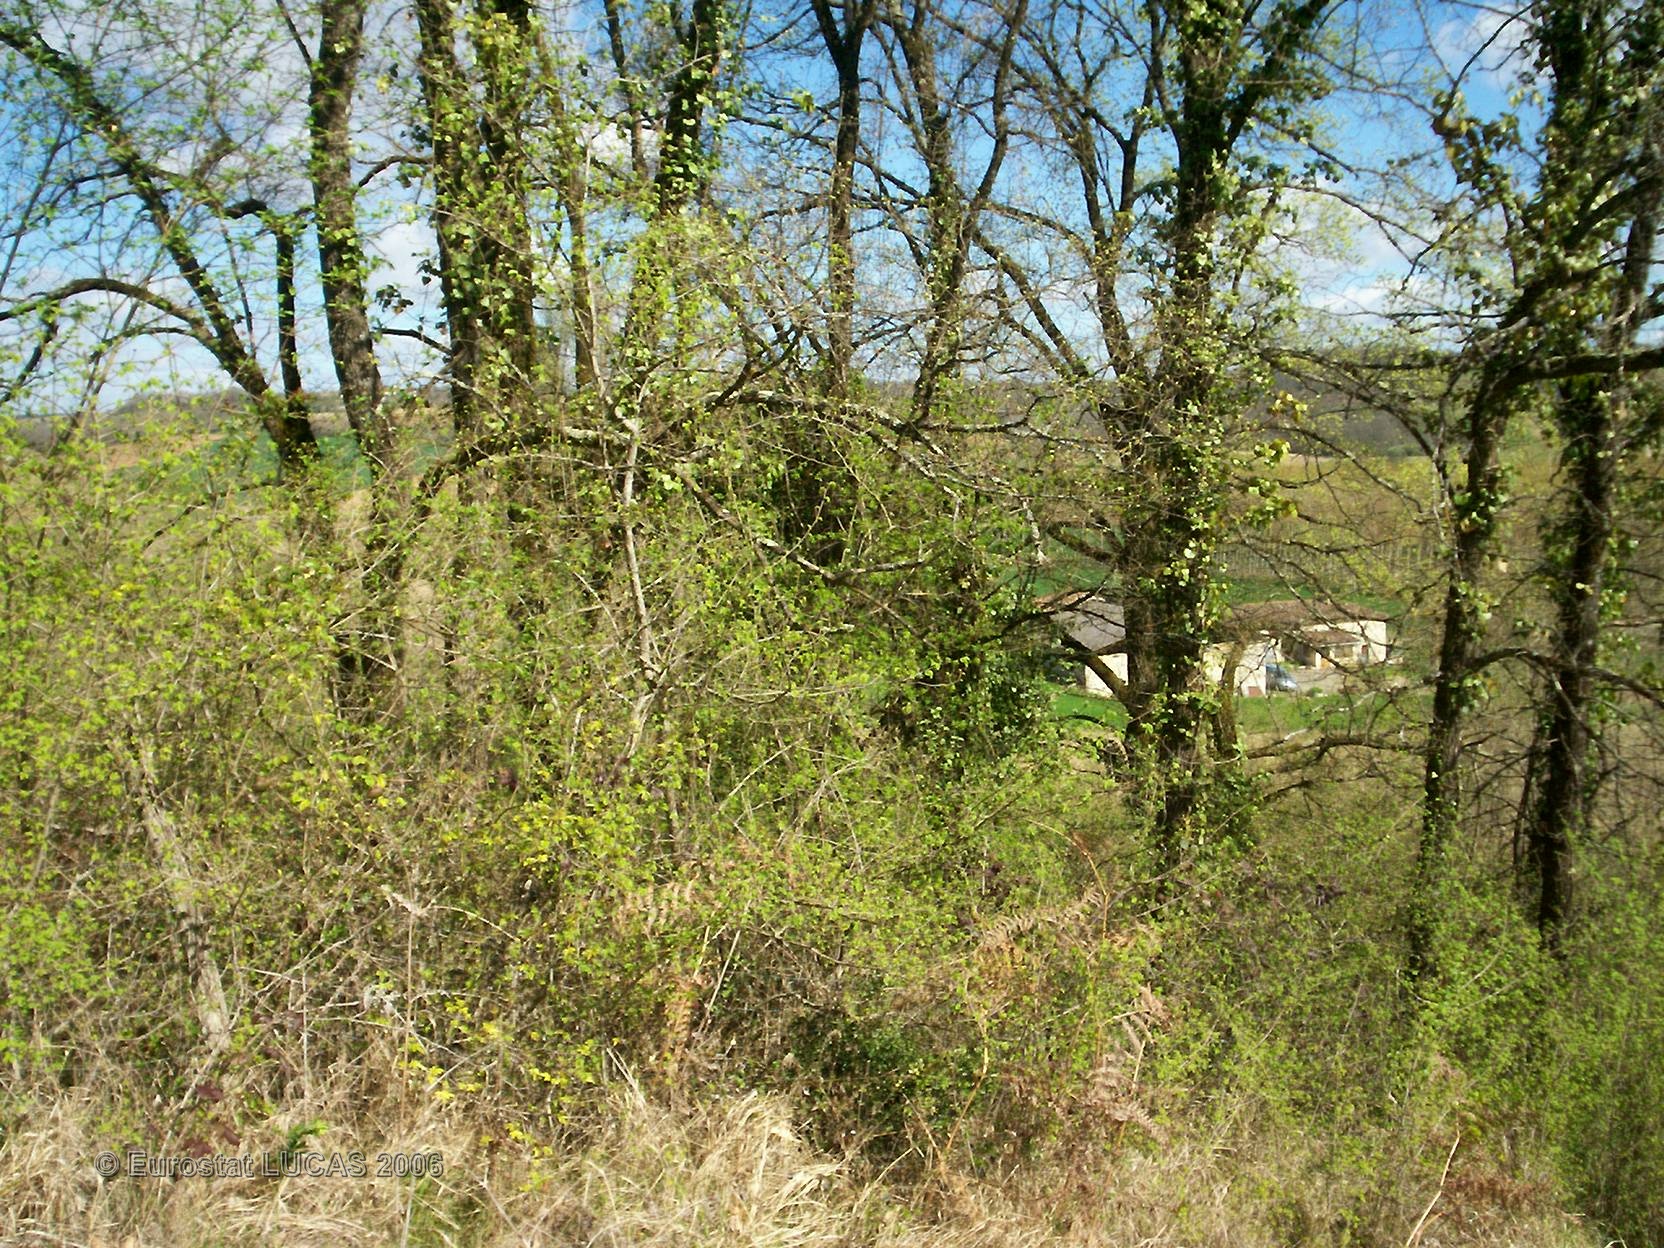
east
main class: Woodland
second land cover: Grassland without tree/shrub cover
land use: Unused
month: April
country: FR
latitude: 44.1860
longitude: 0.9017
